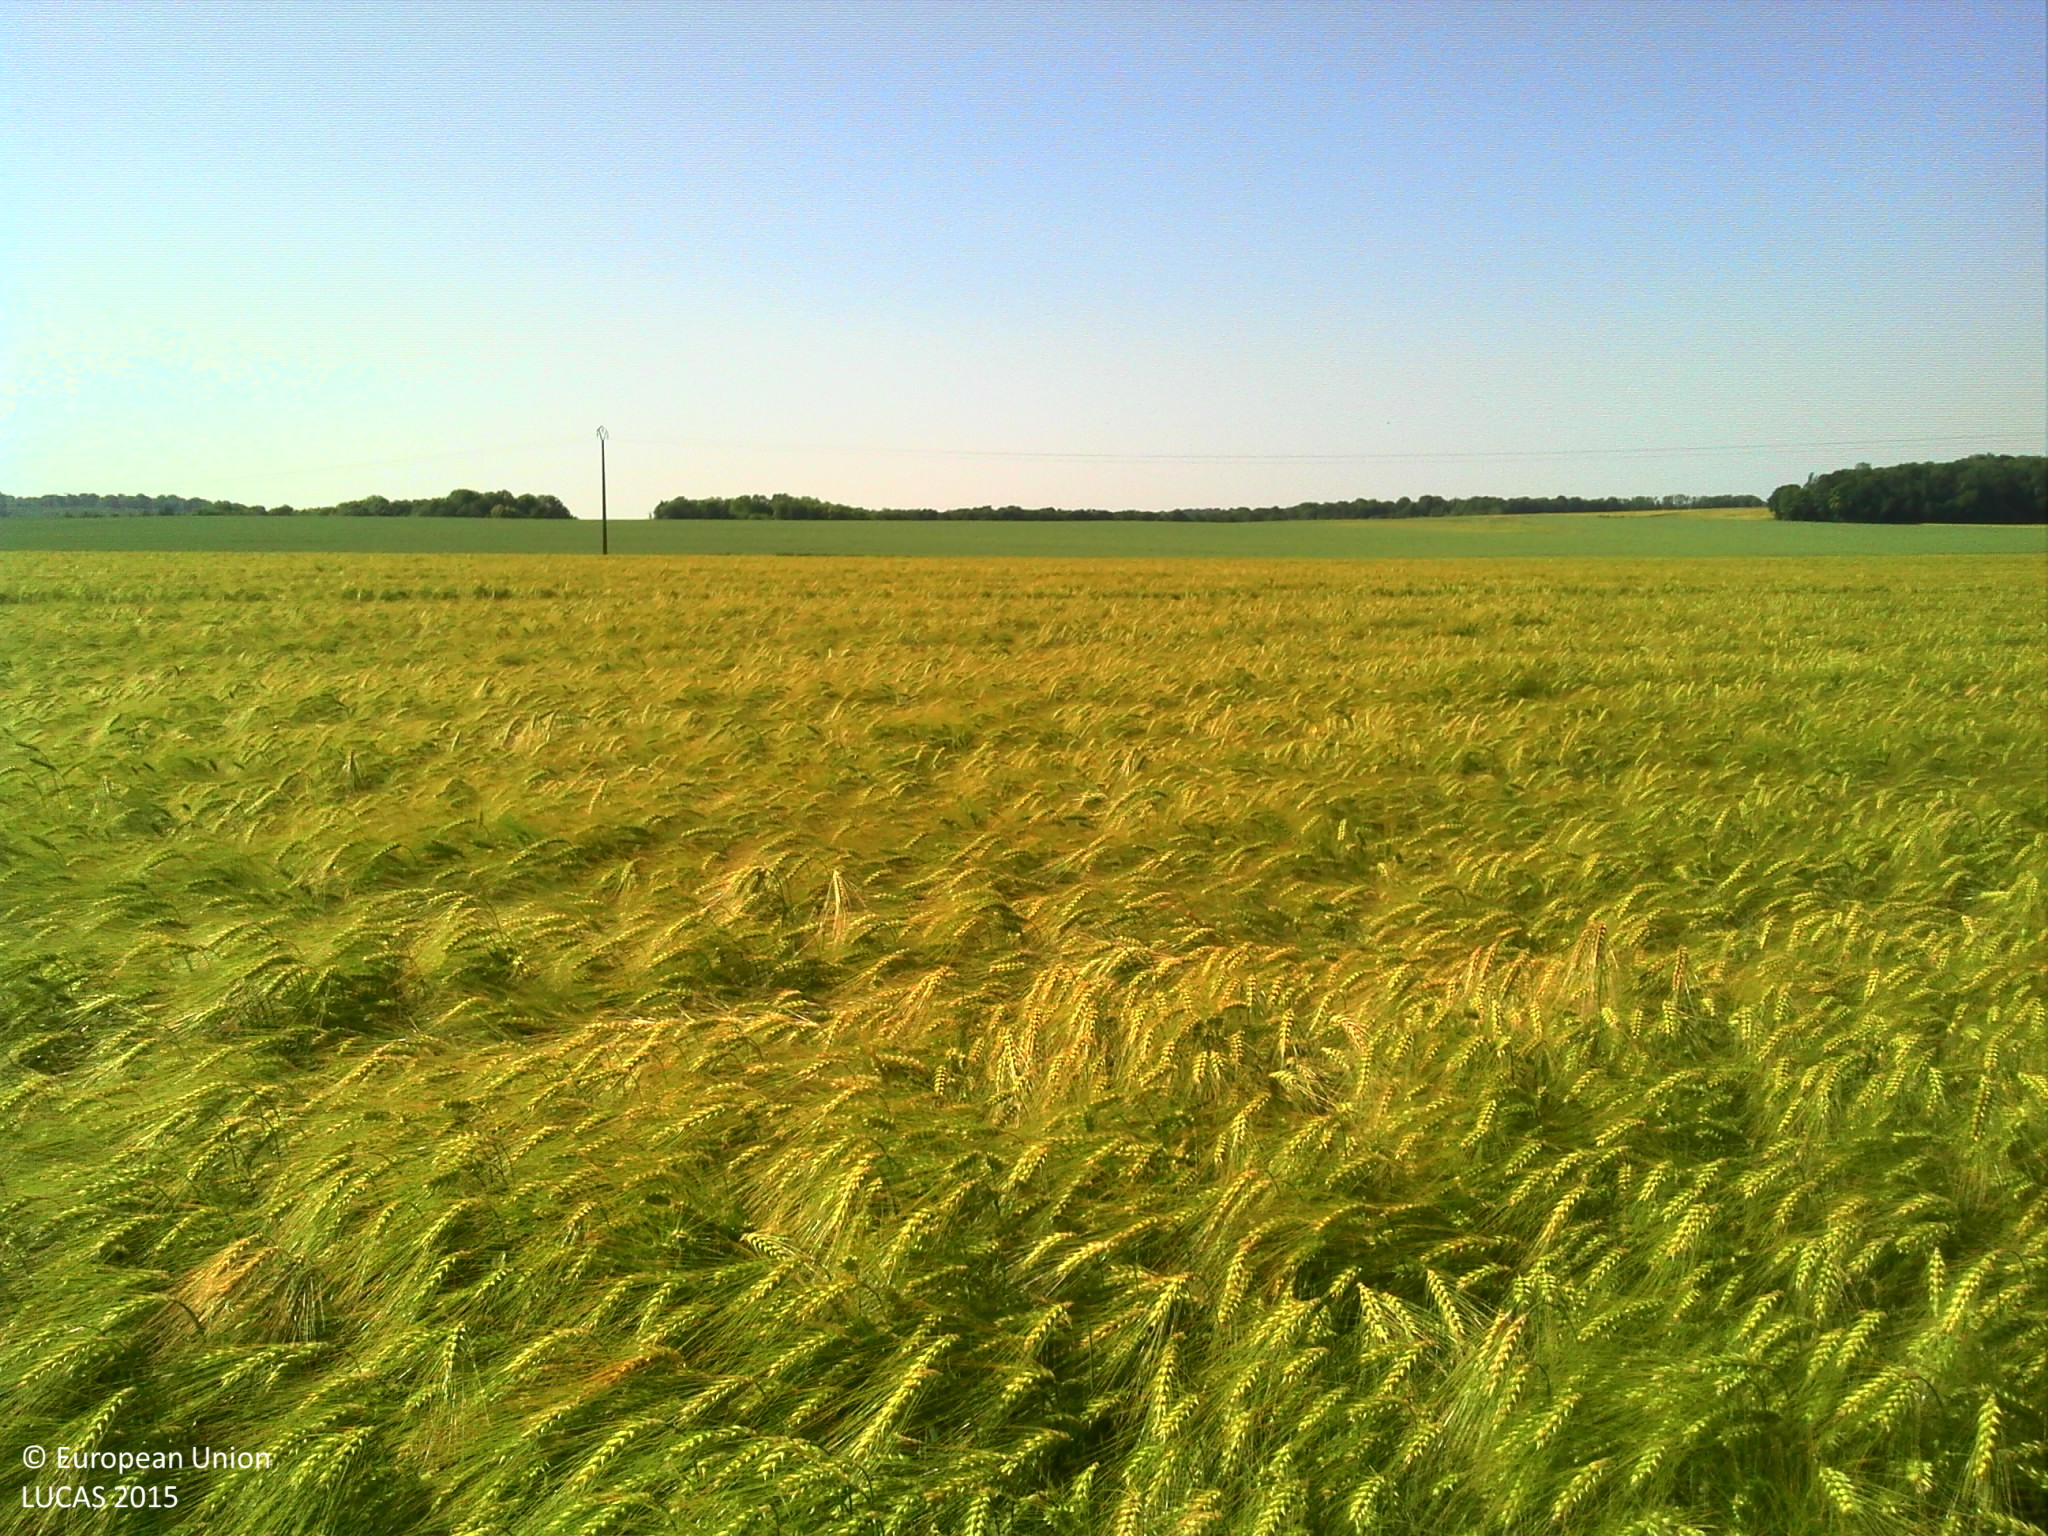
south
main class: Cropland
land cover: Barley
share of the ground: > 75 %
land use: Agriculture (excluding fallow land and kitchen gardens)
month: June
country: FR
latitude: 48.3764
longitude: 4.9085
